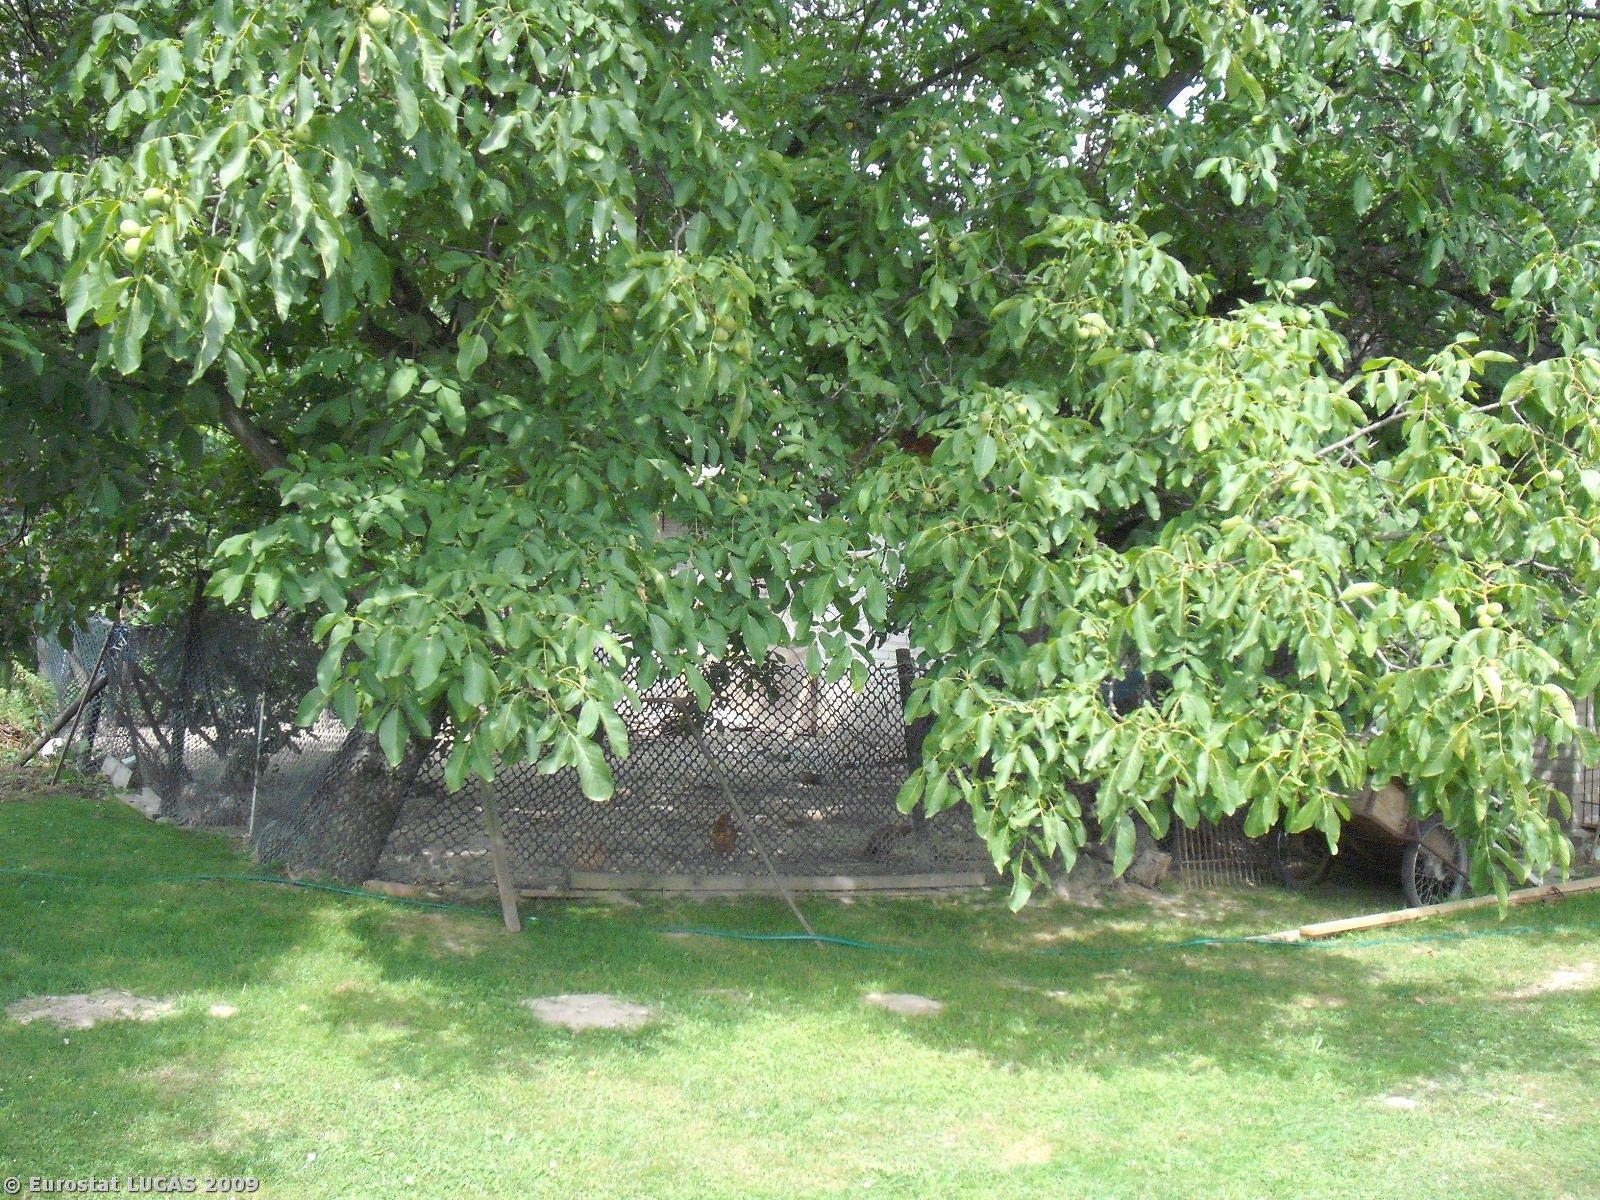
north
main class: Grassland
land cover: Grassland without tree/shrub cover
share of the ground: > 75 %
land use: Residential
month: August
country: PL
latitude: 50.0713
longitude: 22.3725
